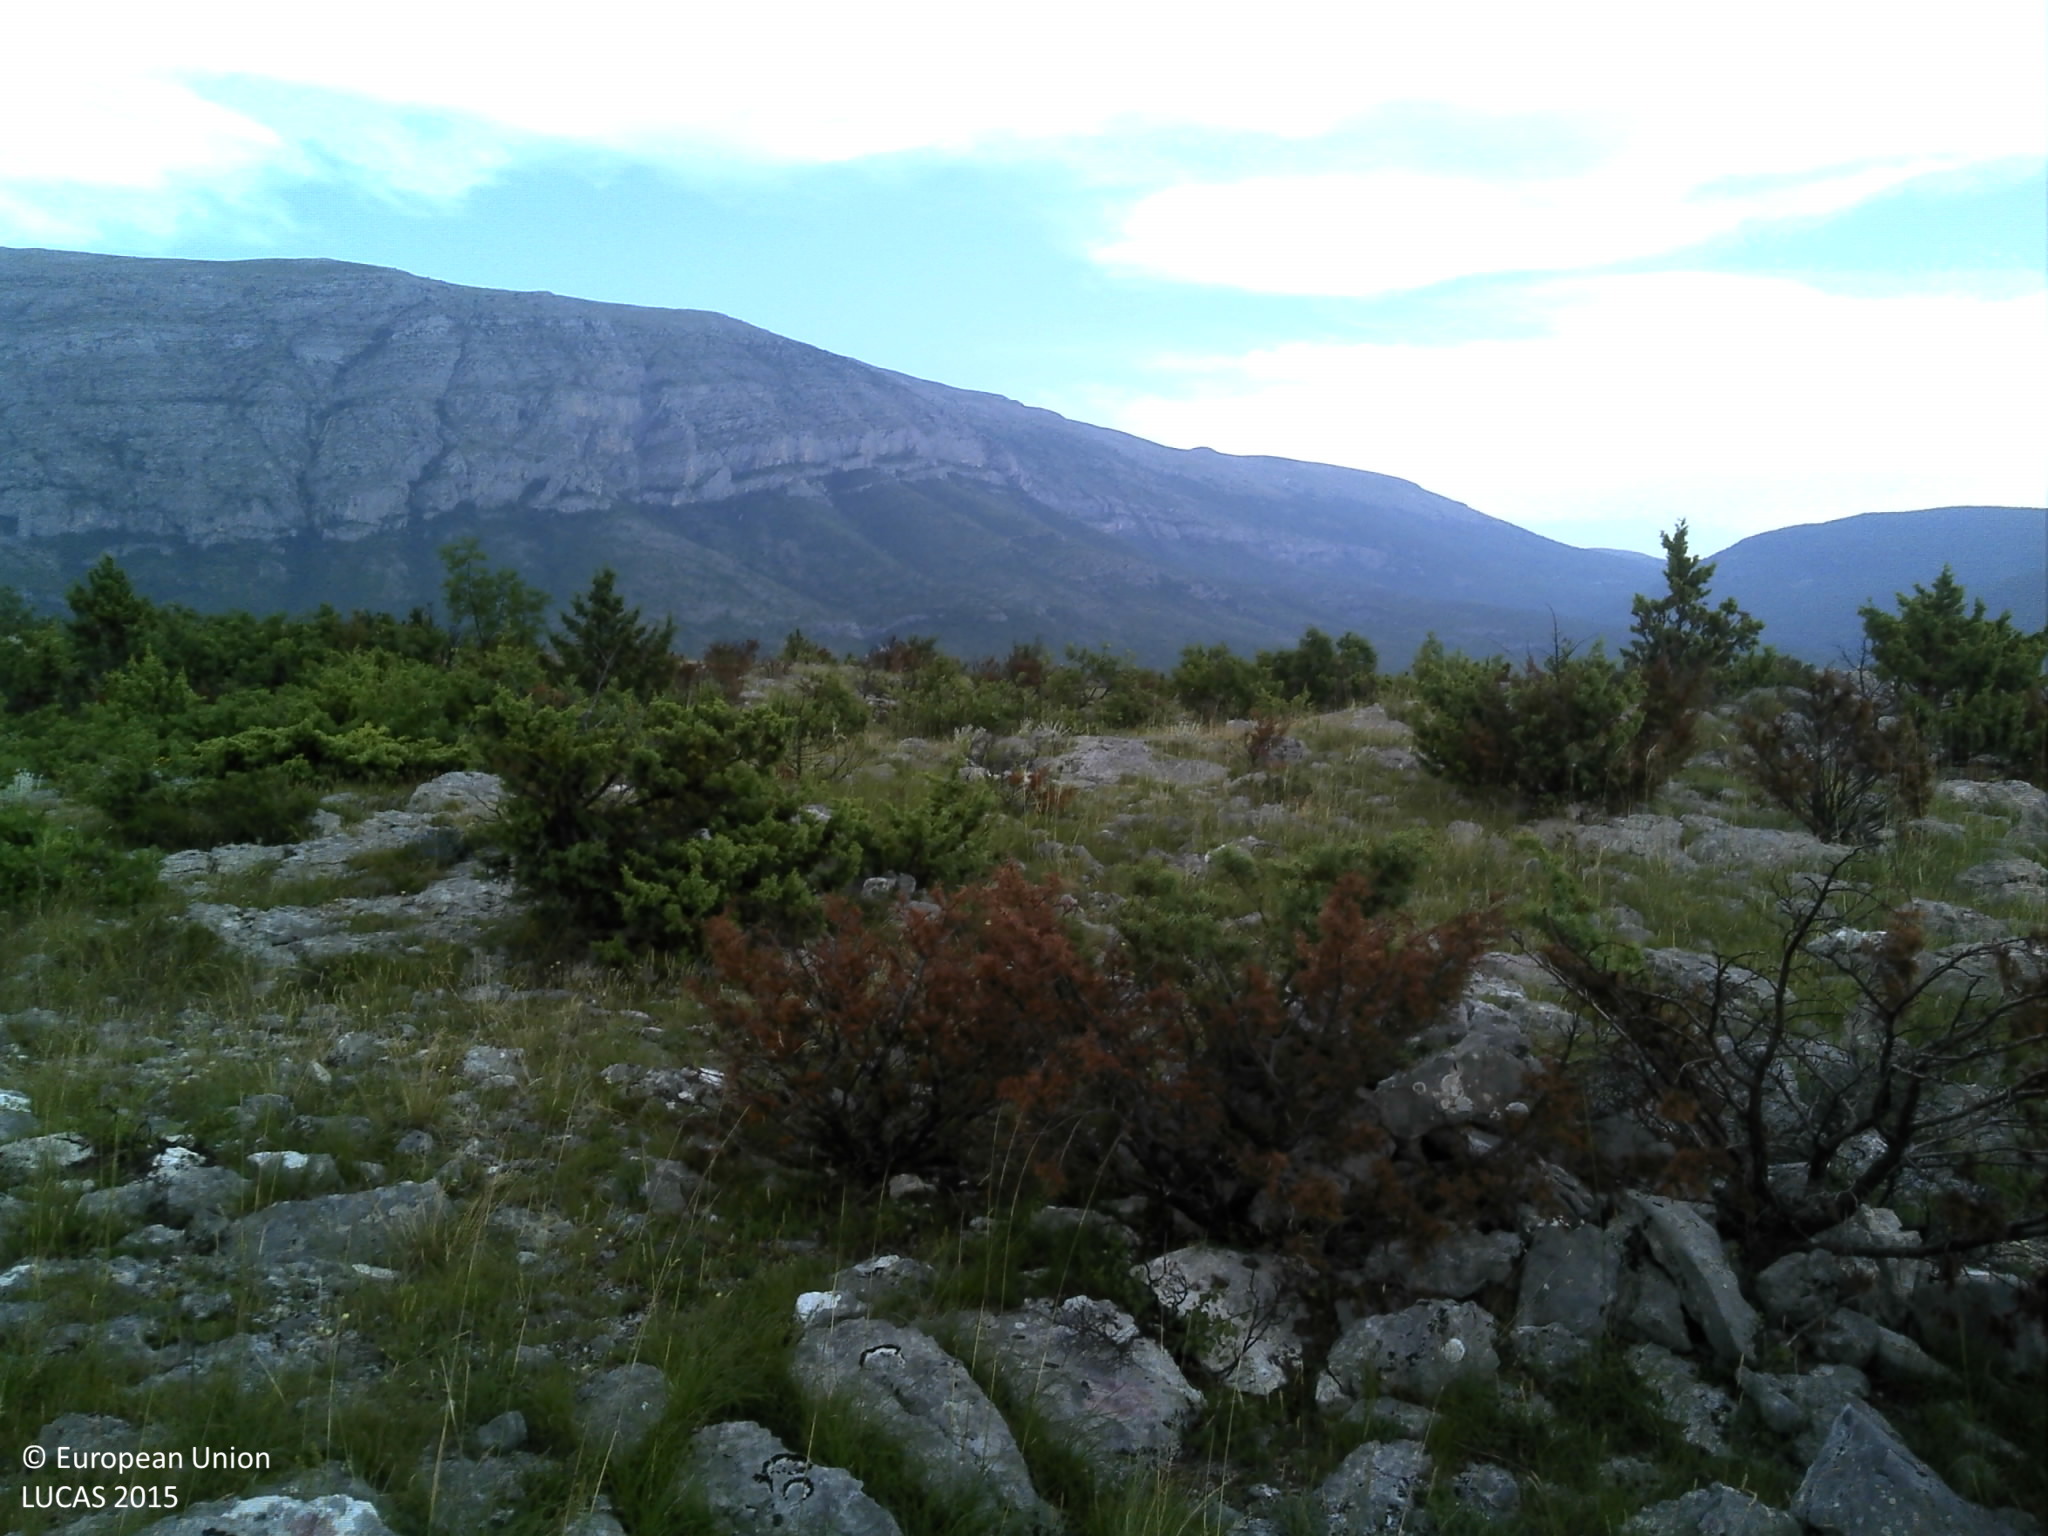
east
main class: Shrubland
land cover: Shrubland with sparse tree cover
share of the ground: 10 - 25 %
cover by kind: herbaceous plants 45 %, shrubs 20 %, unconsolidated bare surface 20 %, consolidated bare surface 10 %, broadleaved forest trees 5 %
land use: Agriculture (excluding fallow land and kitchen gardens)
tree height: < 5 m
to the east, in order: Shrubland with sparse tree cover; Grassland with sparse tree/shrub cover; Broadleaved woodland; Shrubland with sparse tree cover
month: June
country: HR
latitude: 43.9323
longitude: 16.4575
